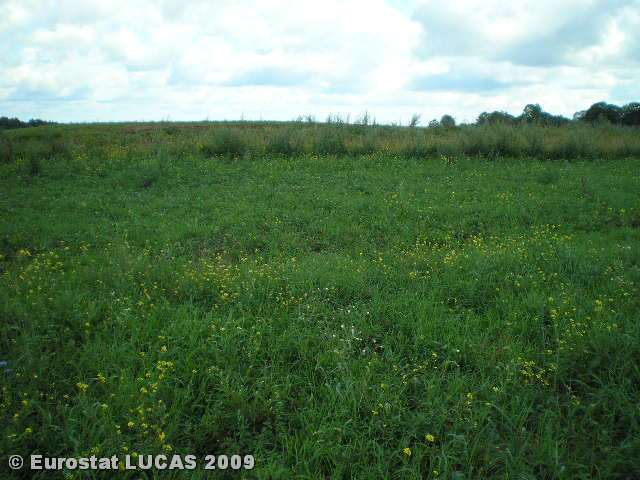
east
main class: Grassland
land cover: Grassland without tree/shrub cover
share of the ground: > 75 %
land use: Agriculture (excluding fallow land and kitchen gardens)
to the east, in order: Grassland without tree/shrub cover; Grass margins; Ditches and canals; Grass margins; Paved roads, cycling and walking lanes; Grass margins; Bare land; Grassland without tree/shrub cover; Bare land; Oats
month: July
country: LT
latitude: 54.9025
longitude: 25.3912
